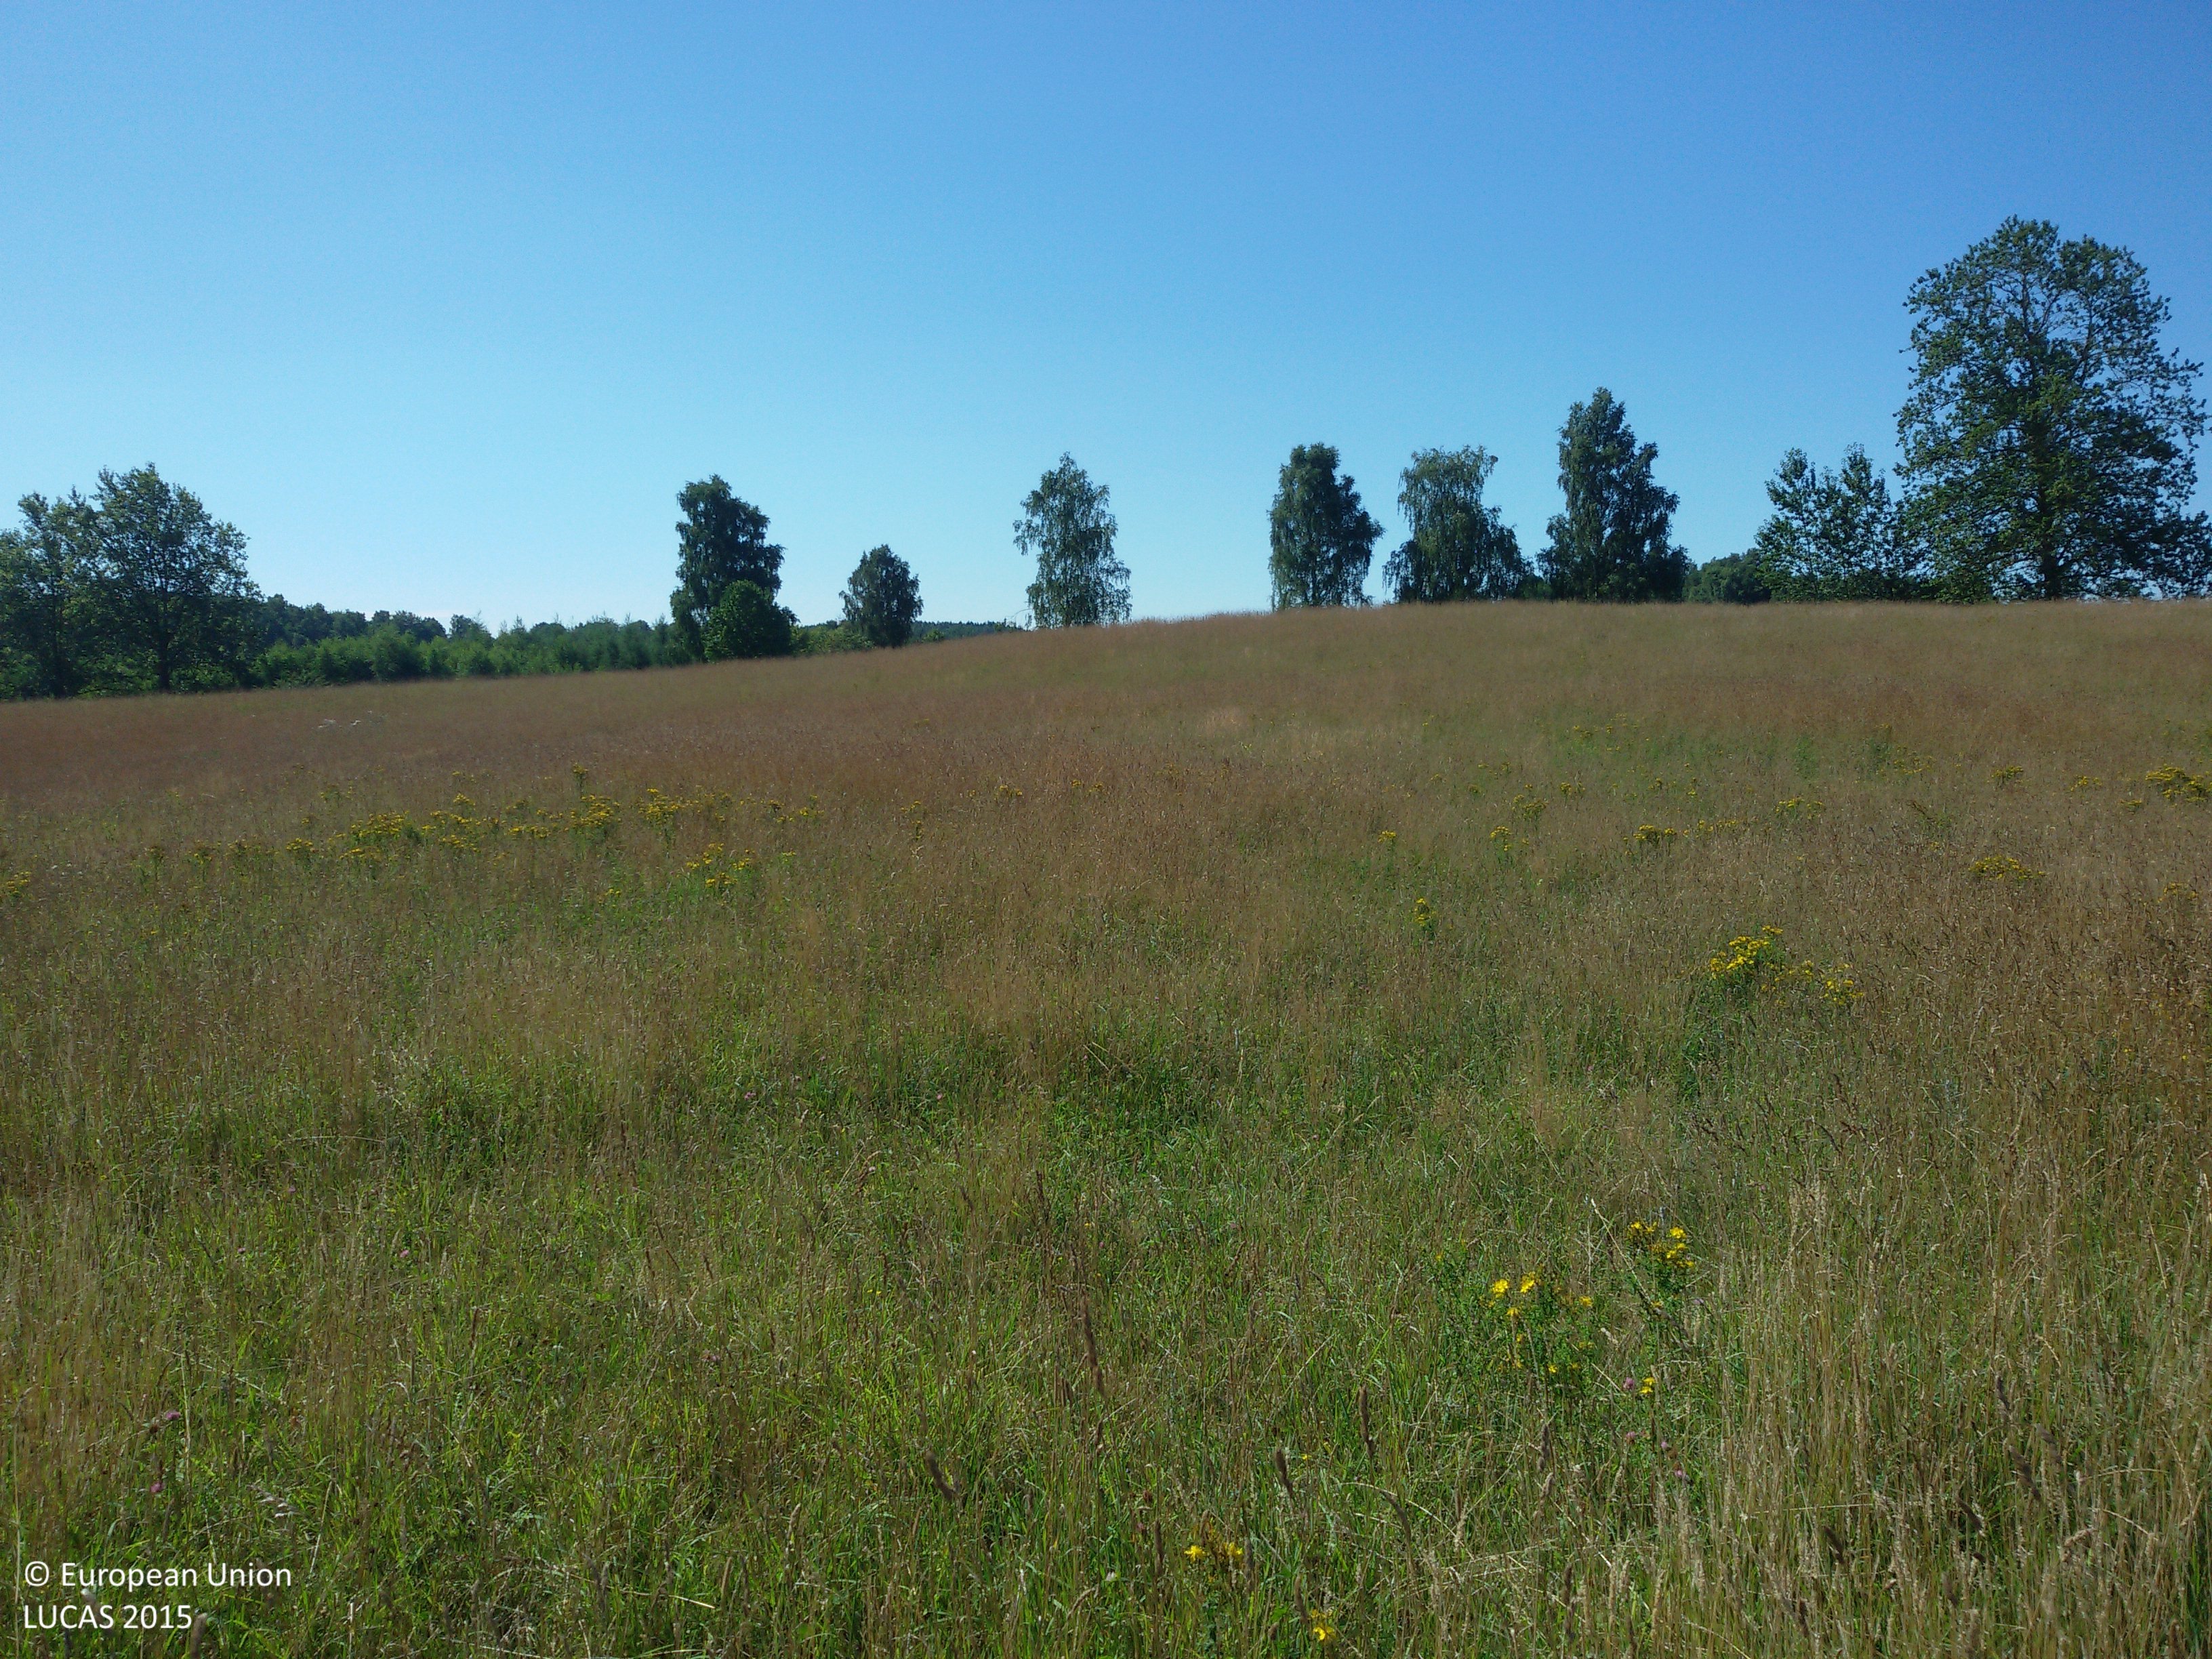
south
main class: Grassland
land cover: Grassland without tree/shrub cover
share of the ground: > 75 %
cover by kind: herbaceous plants 100 %
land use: Agriculture (excluding fallow land and kitchen gardens)
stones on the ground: < 10 %
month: August
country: PL
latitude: 54.1412
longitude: 17.2501
